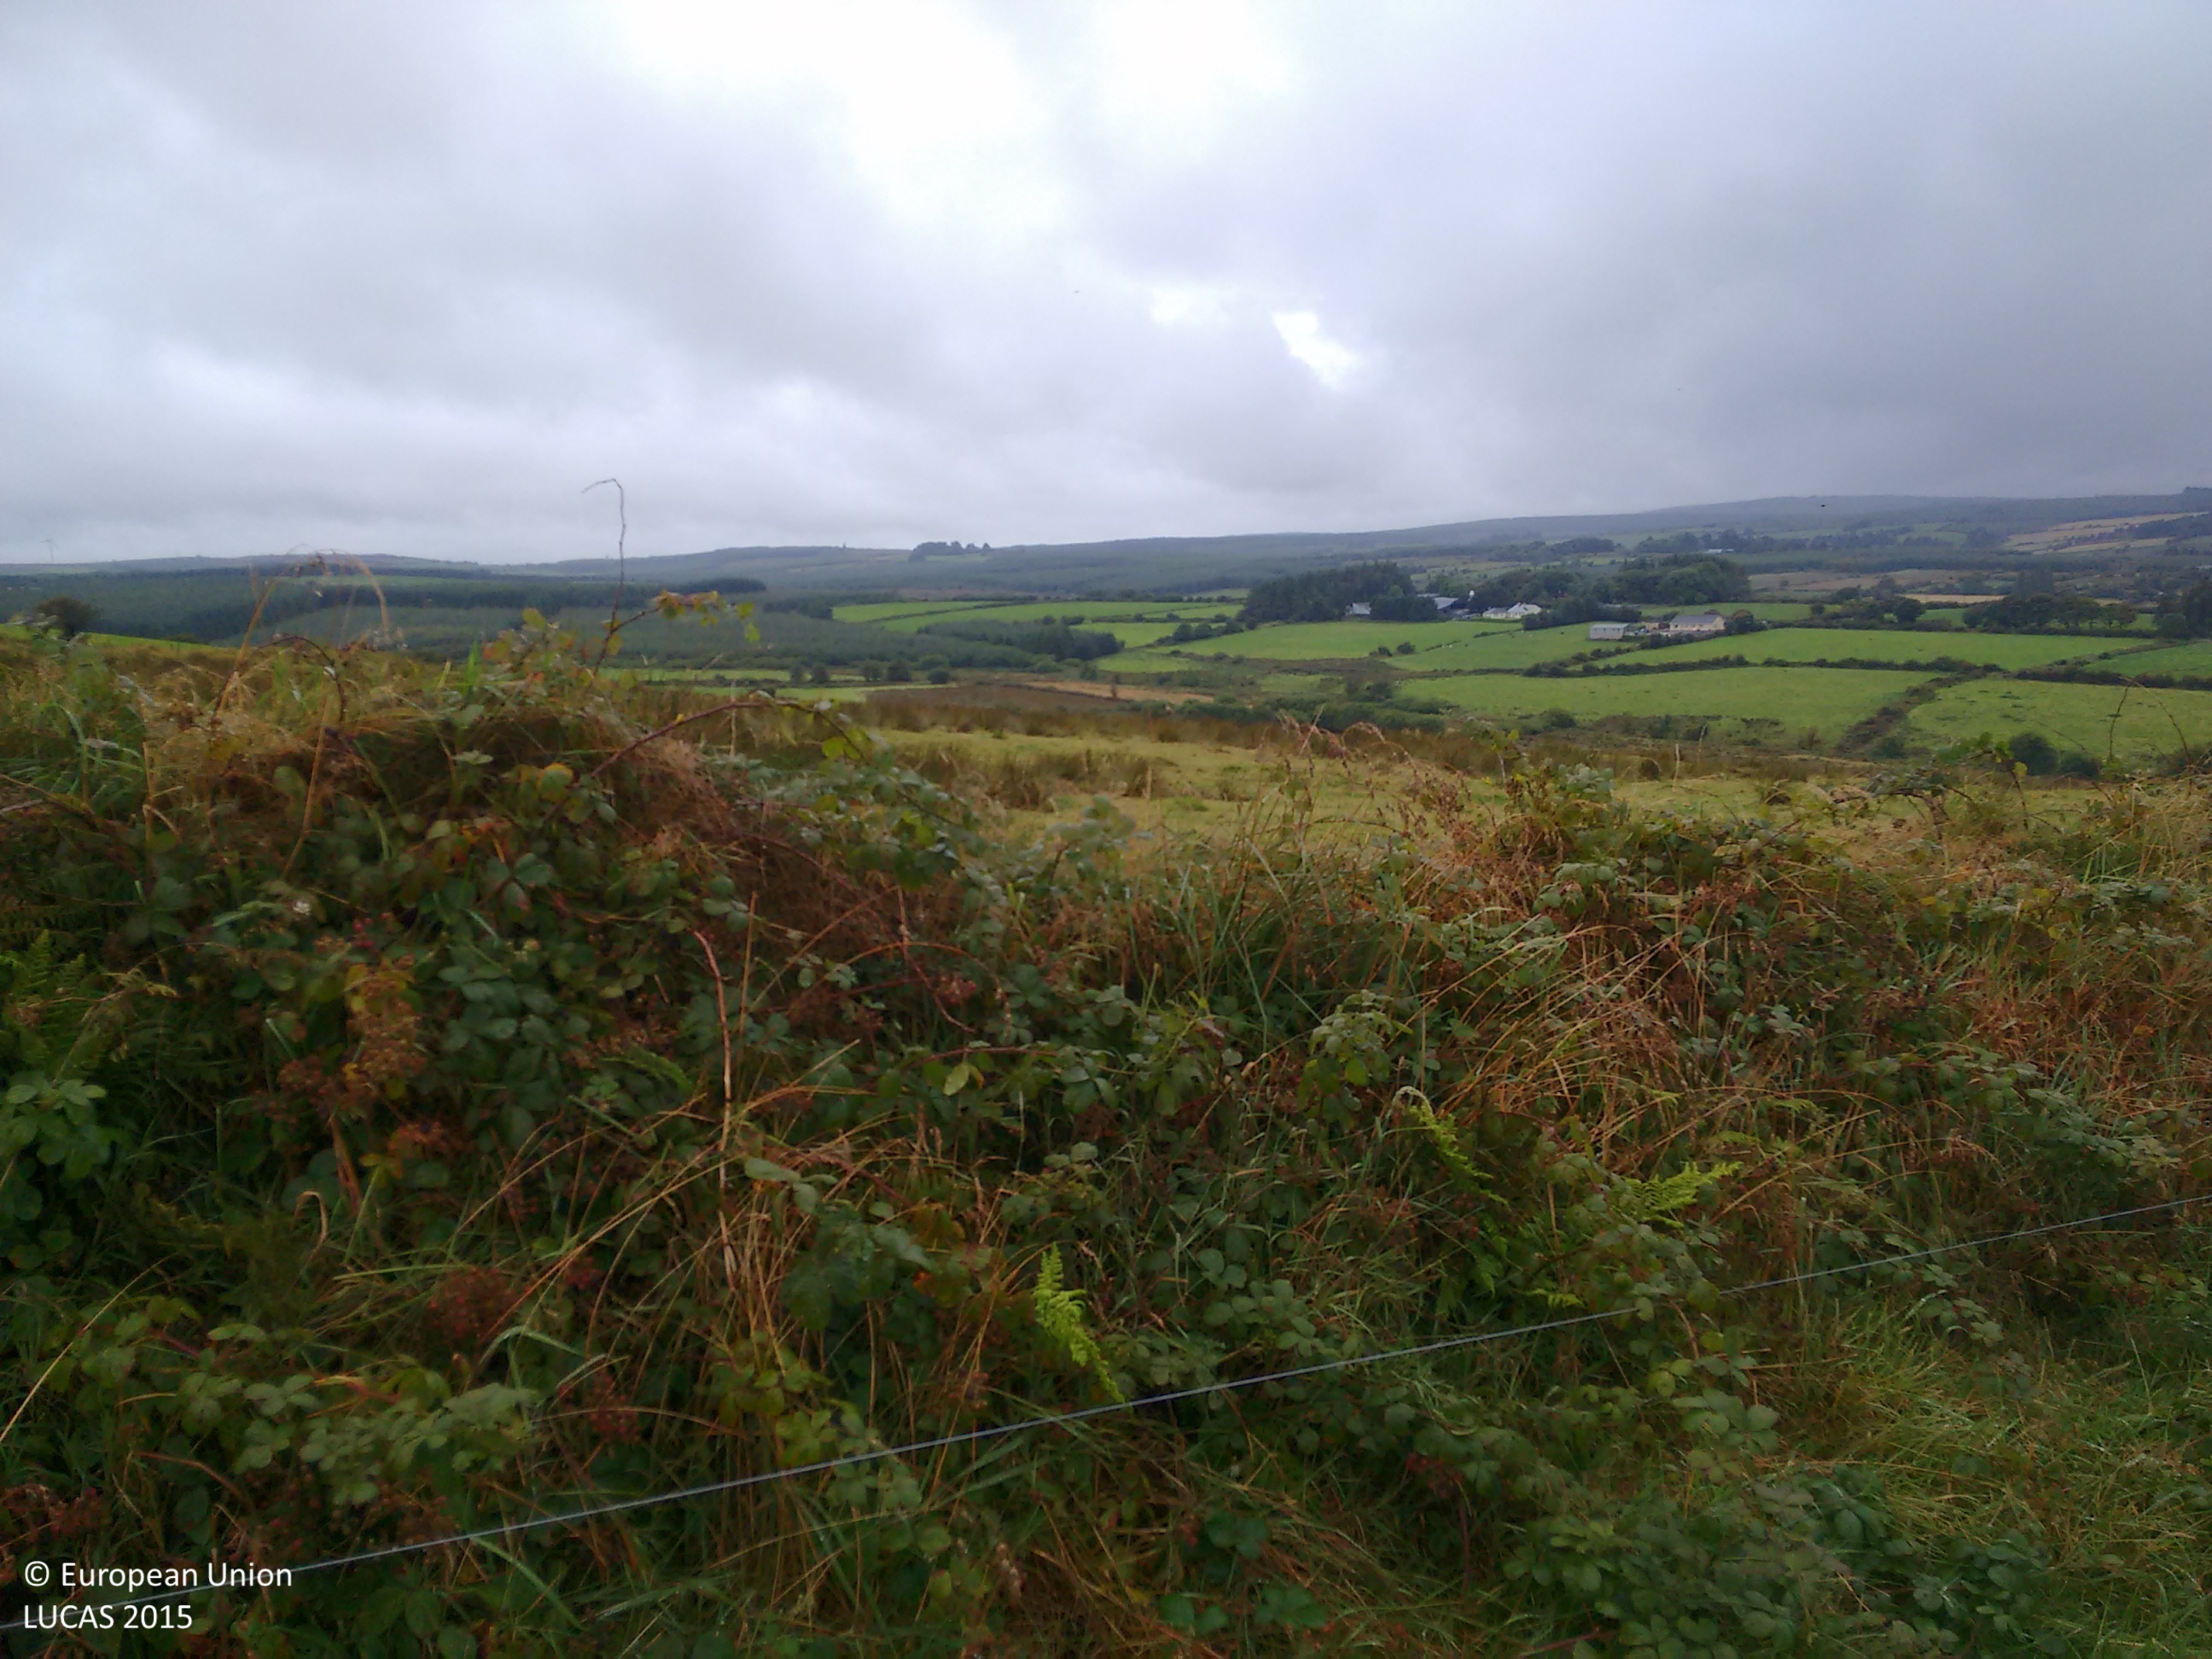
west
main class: Grassland
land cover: Grassland without tree/shrub cover
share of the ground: > 75 %
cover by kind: herbaceous plants 100 %
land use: Agriculture (excluding fallow land and kitchen gardens)
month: September
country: IE
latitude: 52.2801
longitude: -9.0196
